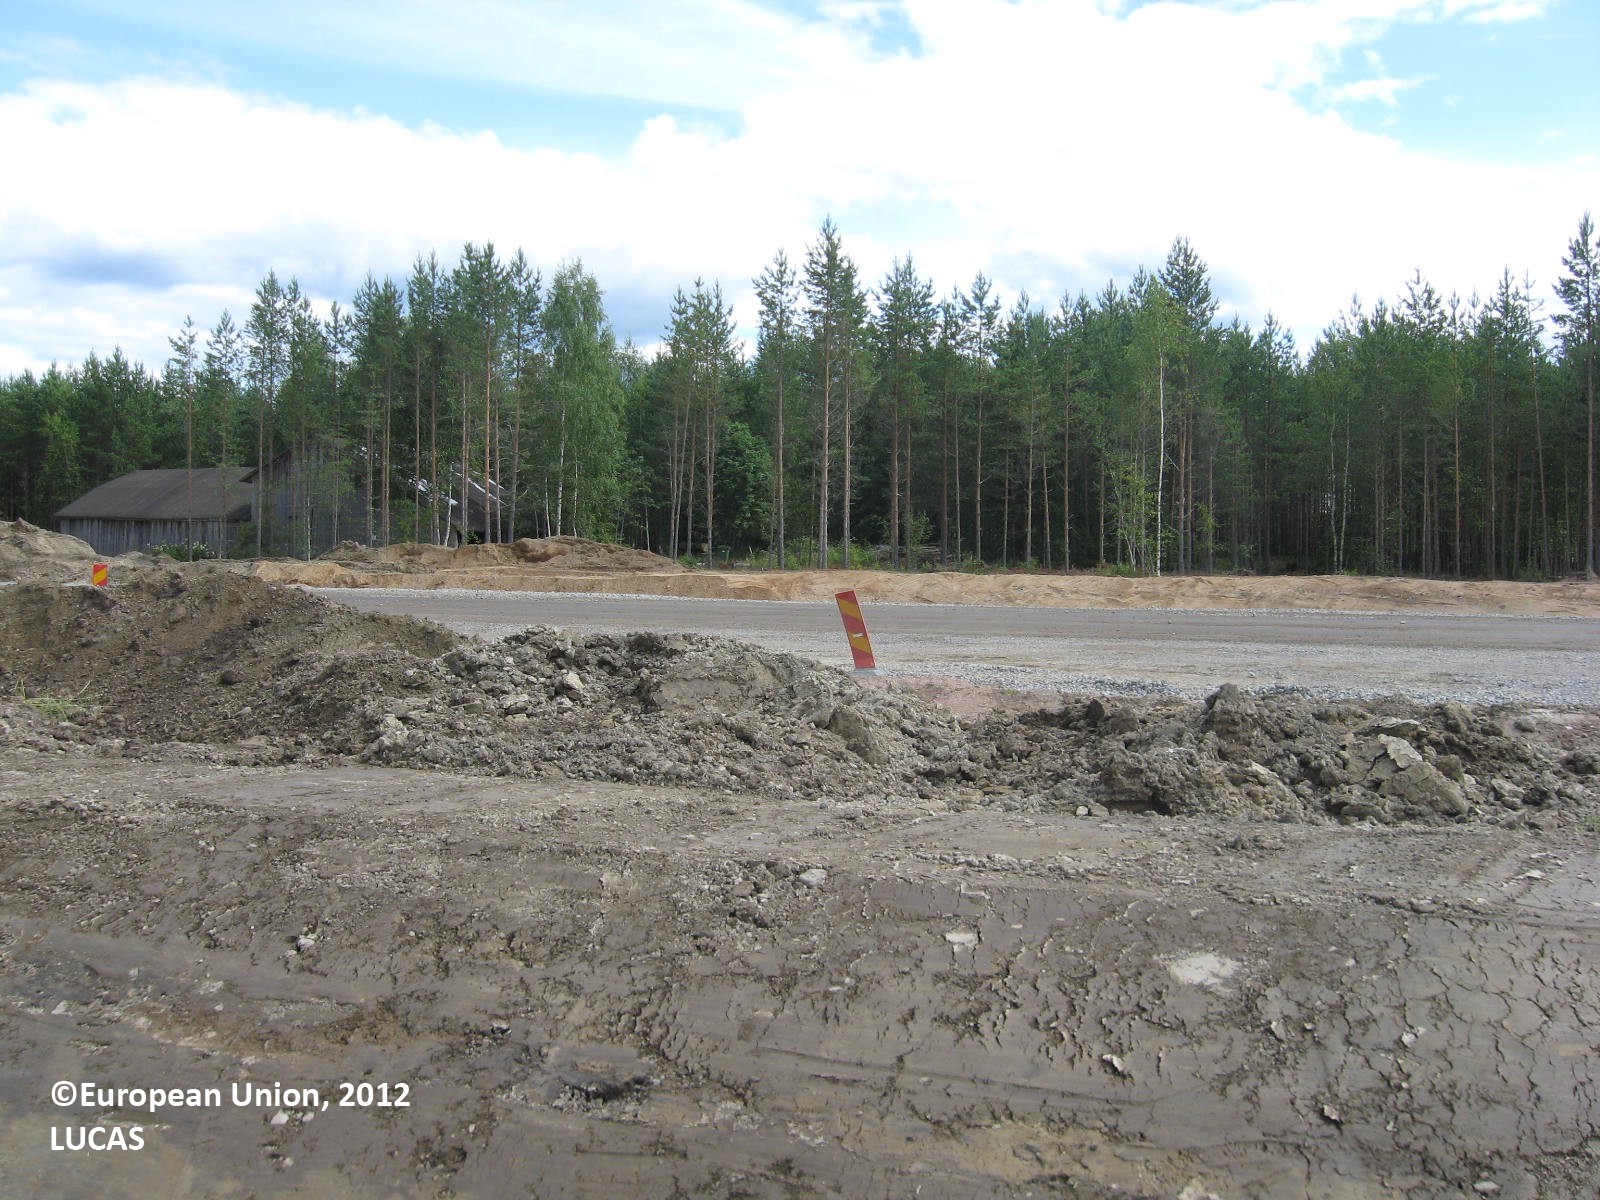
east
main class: Cropland
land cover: Oats
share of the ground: > 75 %
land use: Agriculture (excluding fallow land and kitchen gardens)
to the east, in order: Oats; Other bare soil; Ditches and canals; Other bare soil; Tracks; Rocks and stones; Sand; Ditches and canals; Sand; Pine dominated coniferous woodland; Paved roads, cycling and walking lanes; Pine dominated mixed woodland; Tracks; Pine dominated coniferous woodland; Tracks; Pine dominated mixed woodland; Oats
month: July
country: FI
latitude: 62.0206
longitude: 22.2267
